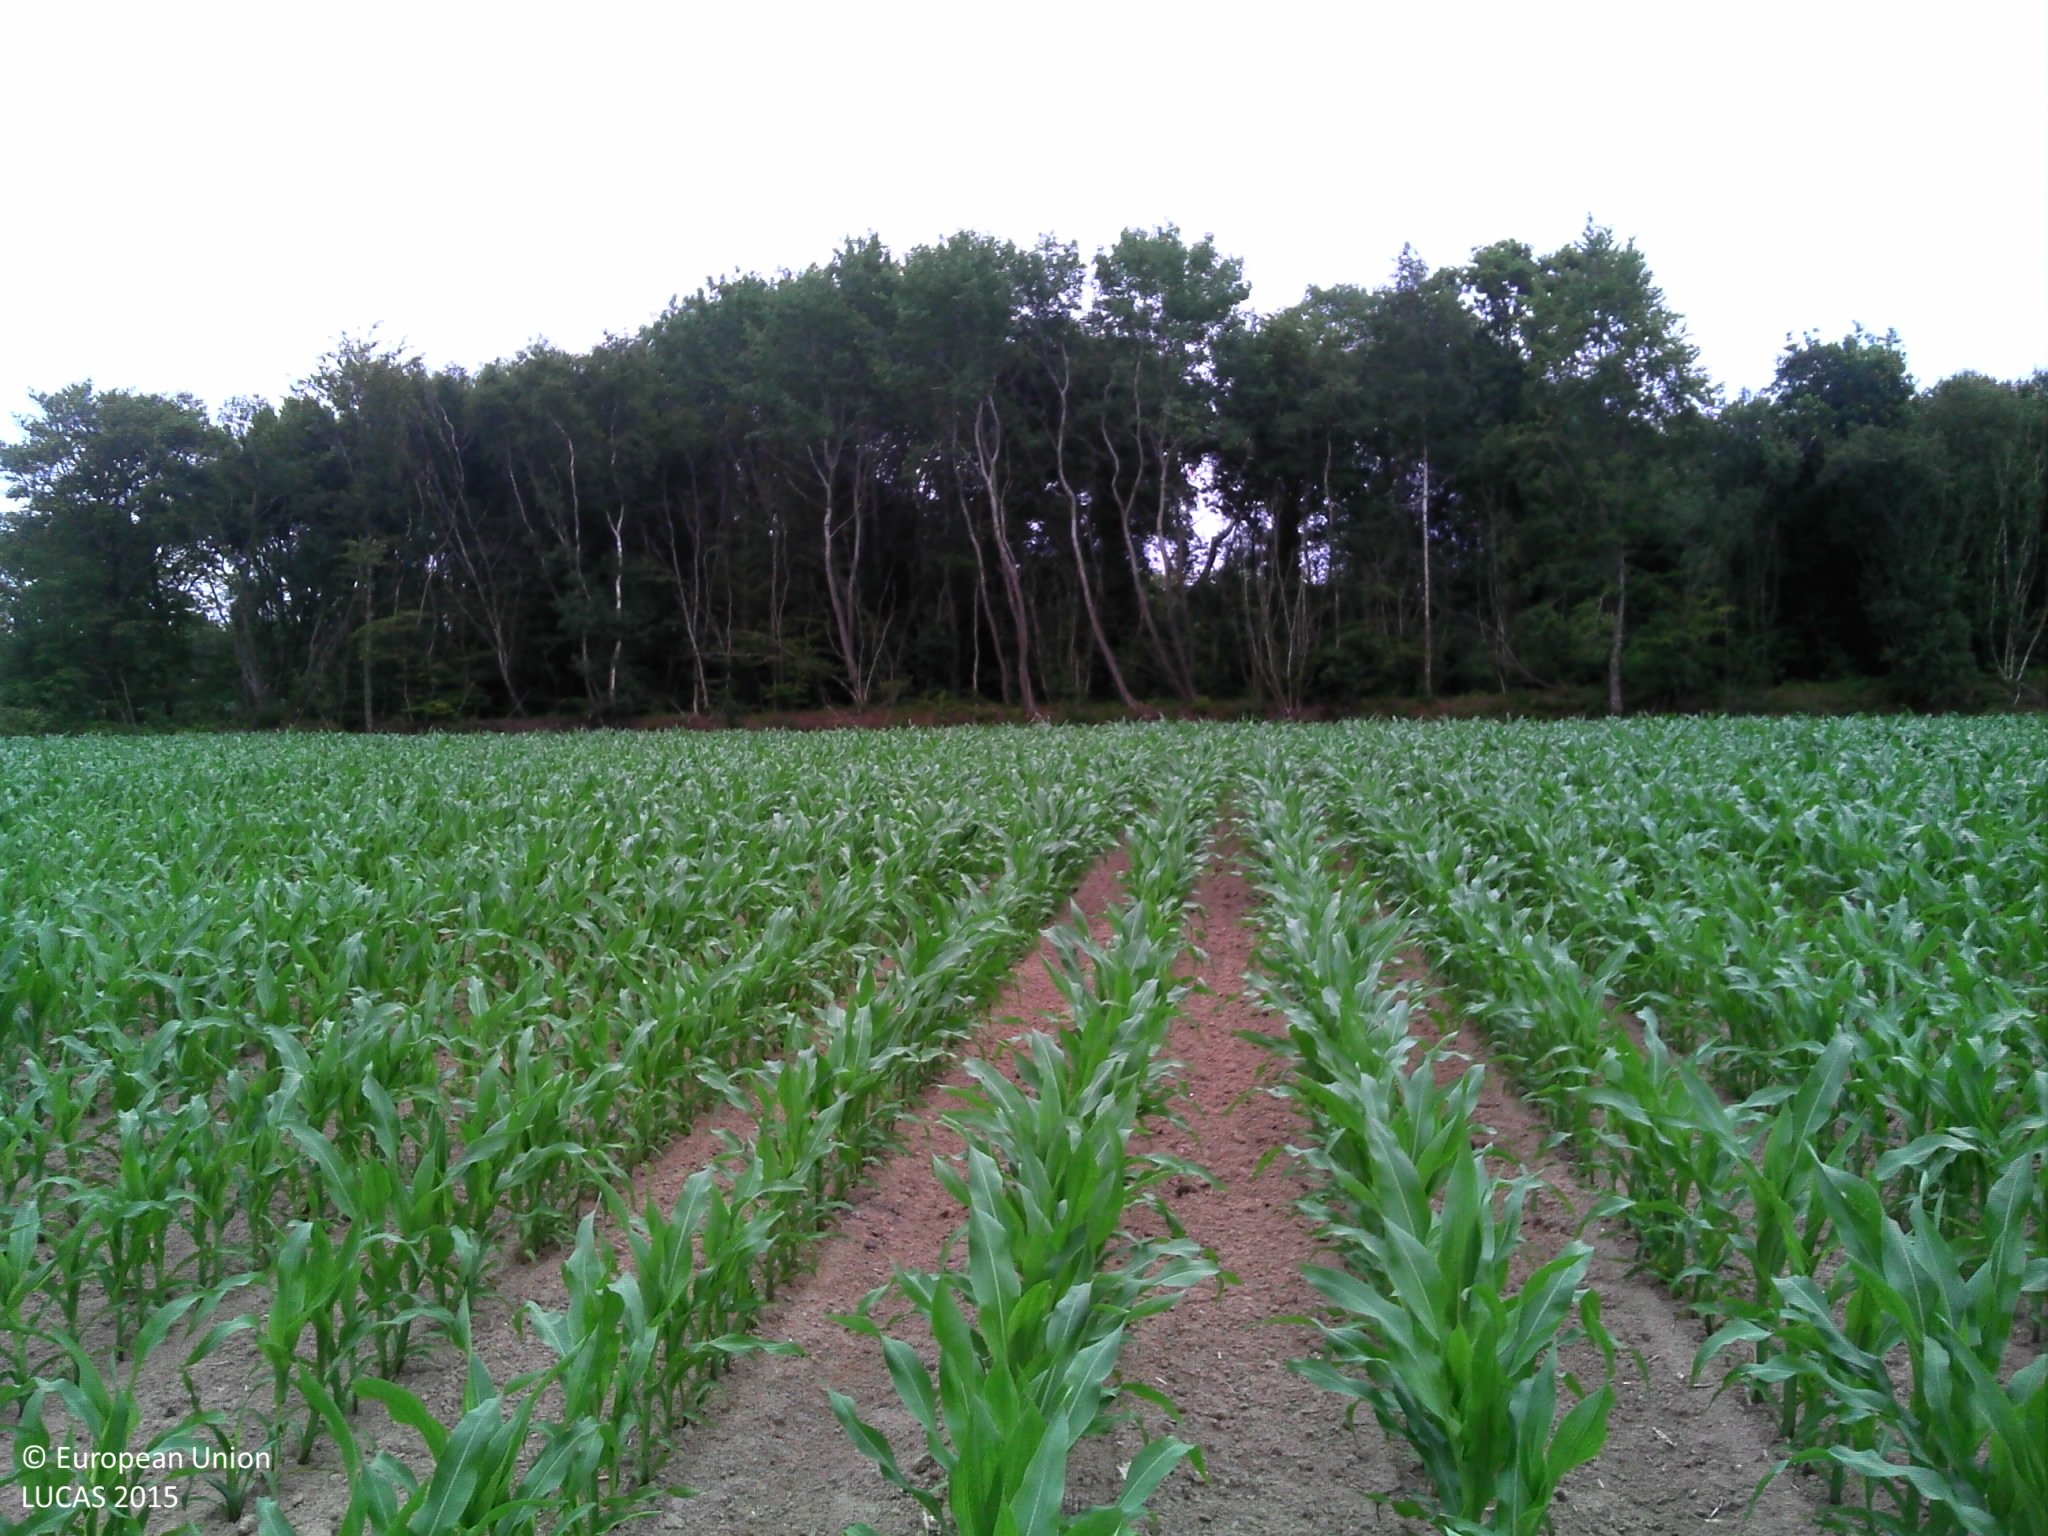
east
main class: Cropland
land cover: Maize
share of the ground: 50 - 75 %
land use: Agriculture (excluding fallow land and kitchen gardens)
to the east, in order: Electric lines; Maize; Spontaneously vegetated surfaces; Broadleaved woodland; Grass margins; Lines of trees; Mixed cereals for fodder
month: July
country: FR
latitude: 48.6610
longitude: -3.5348
